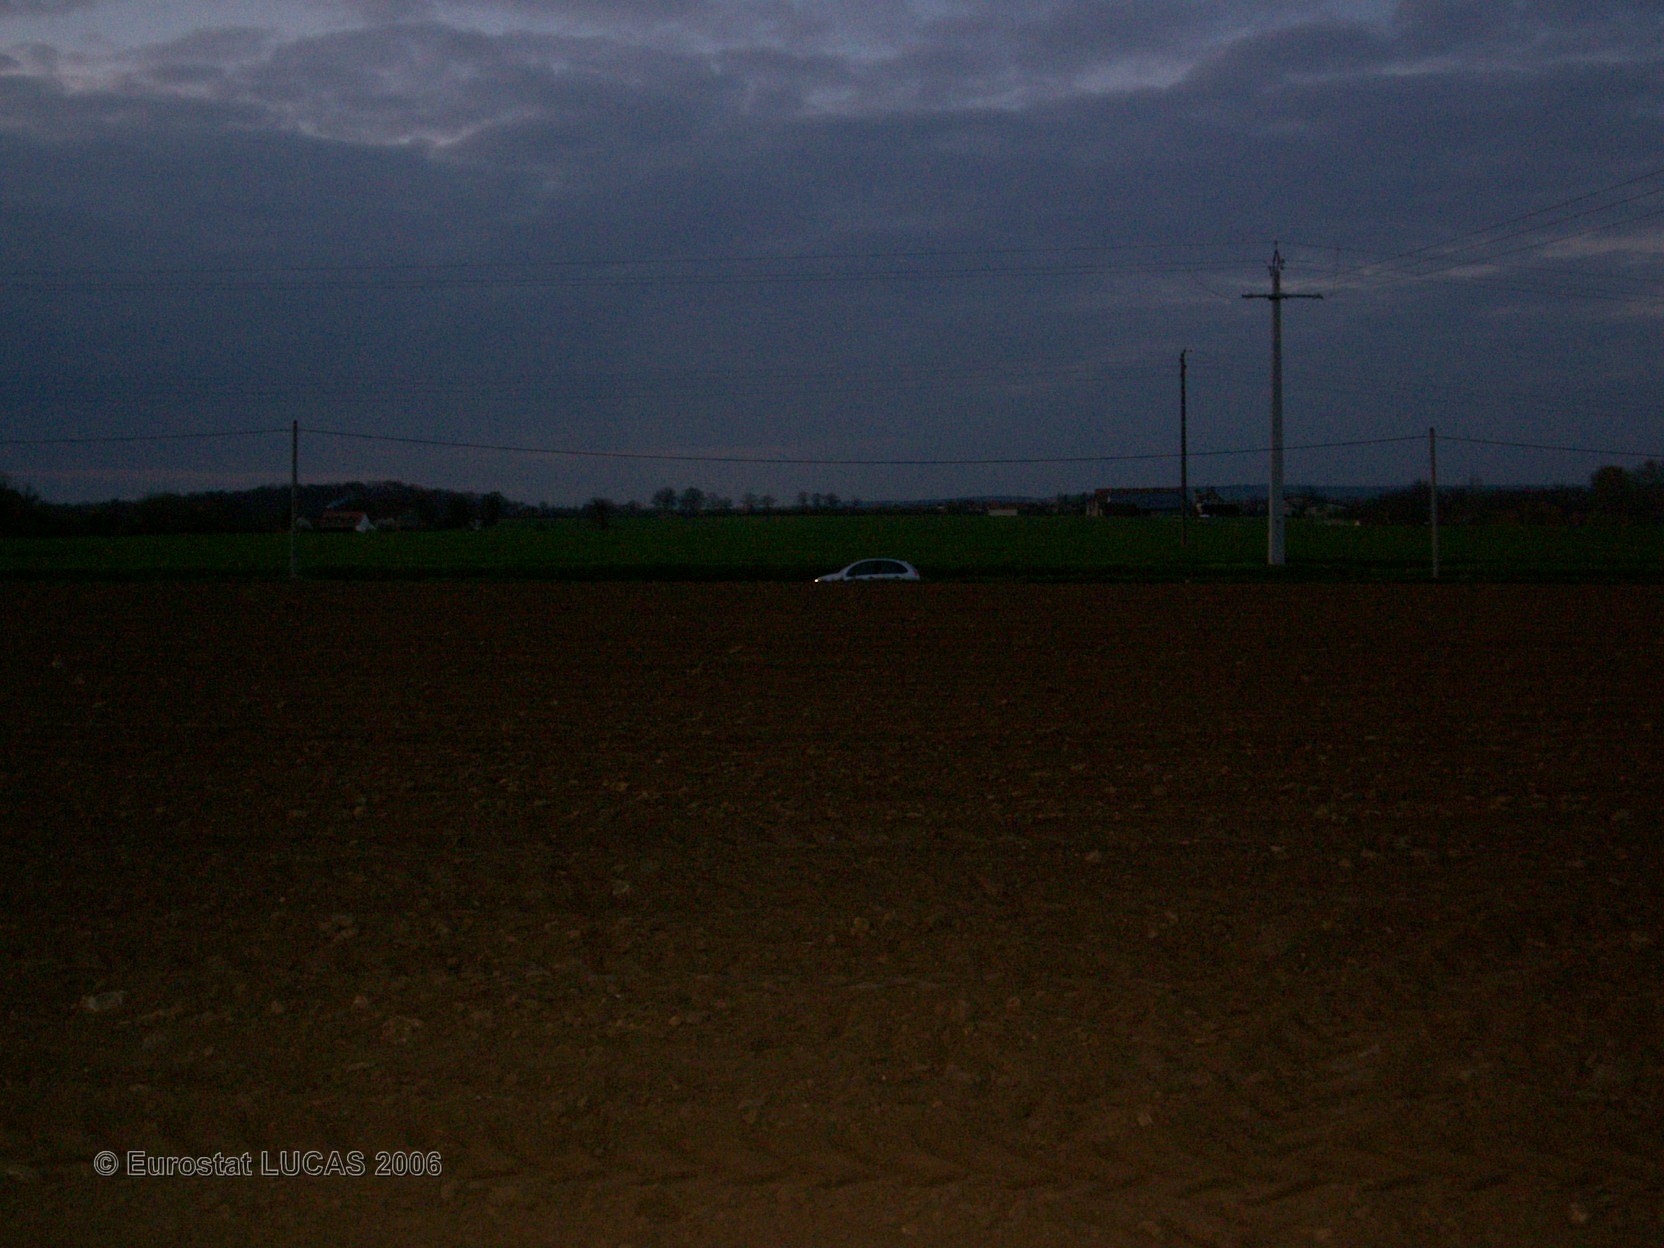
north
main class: Cropland
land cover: Maize
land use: Agriculture (excluding fallow land and kitchen gardens)
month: April
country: FR
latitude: 48.2863
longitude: 0.1204
